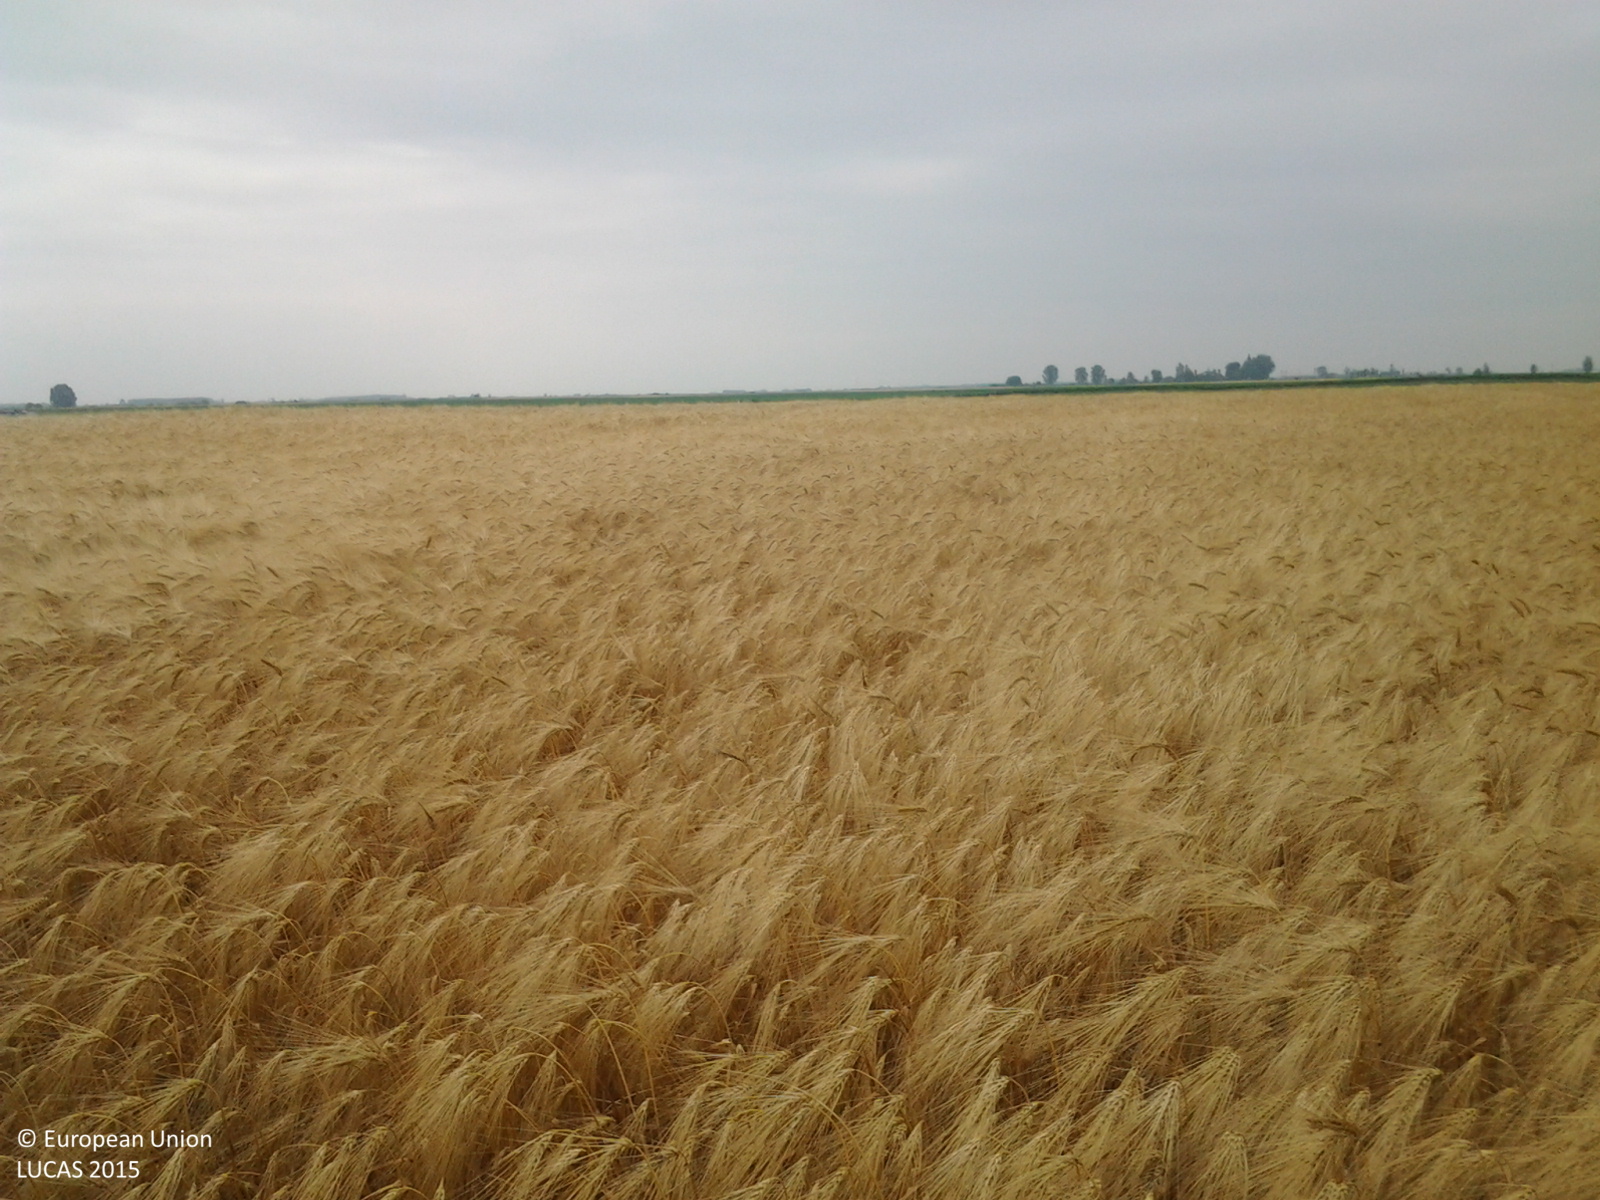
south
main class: Cropland
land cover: Barley
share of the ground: > 75 %
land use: Agriculture (excluding fallow land and kitchen gardens)
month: June
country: HU
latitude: 46.4616
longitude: 18.9849
